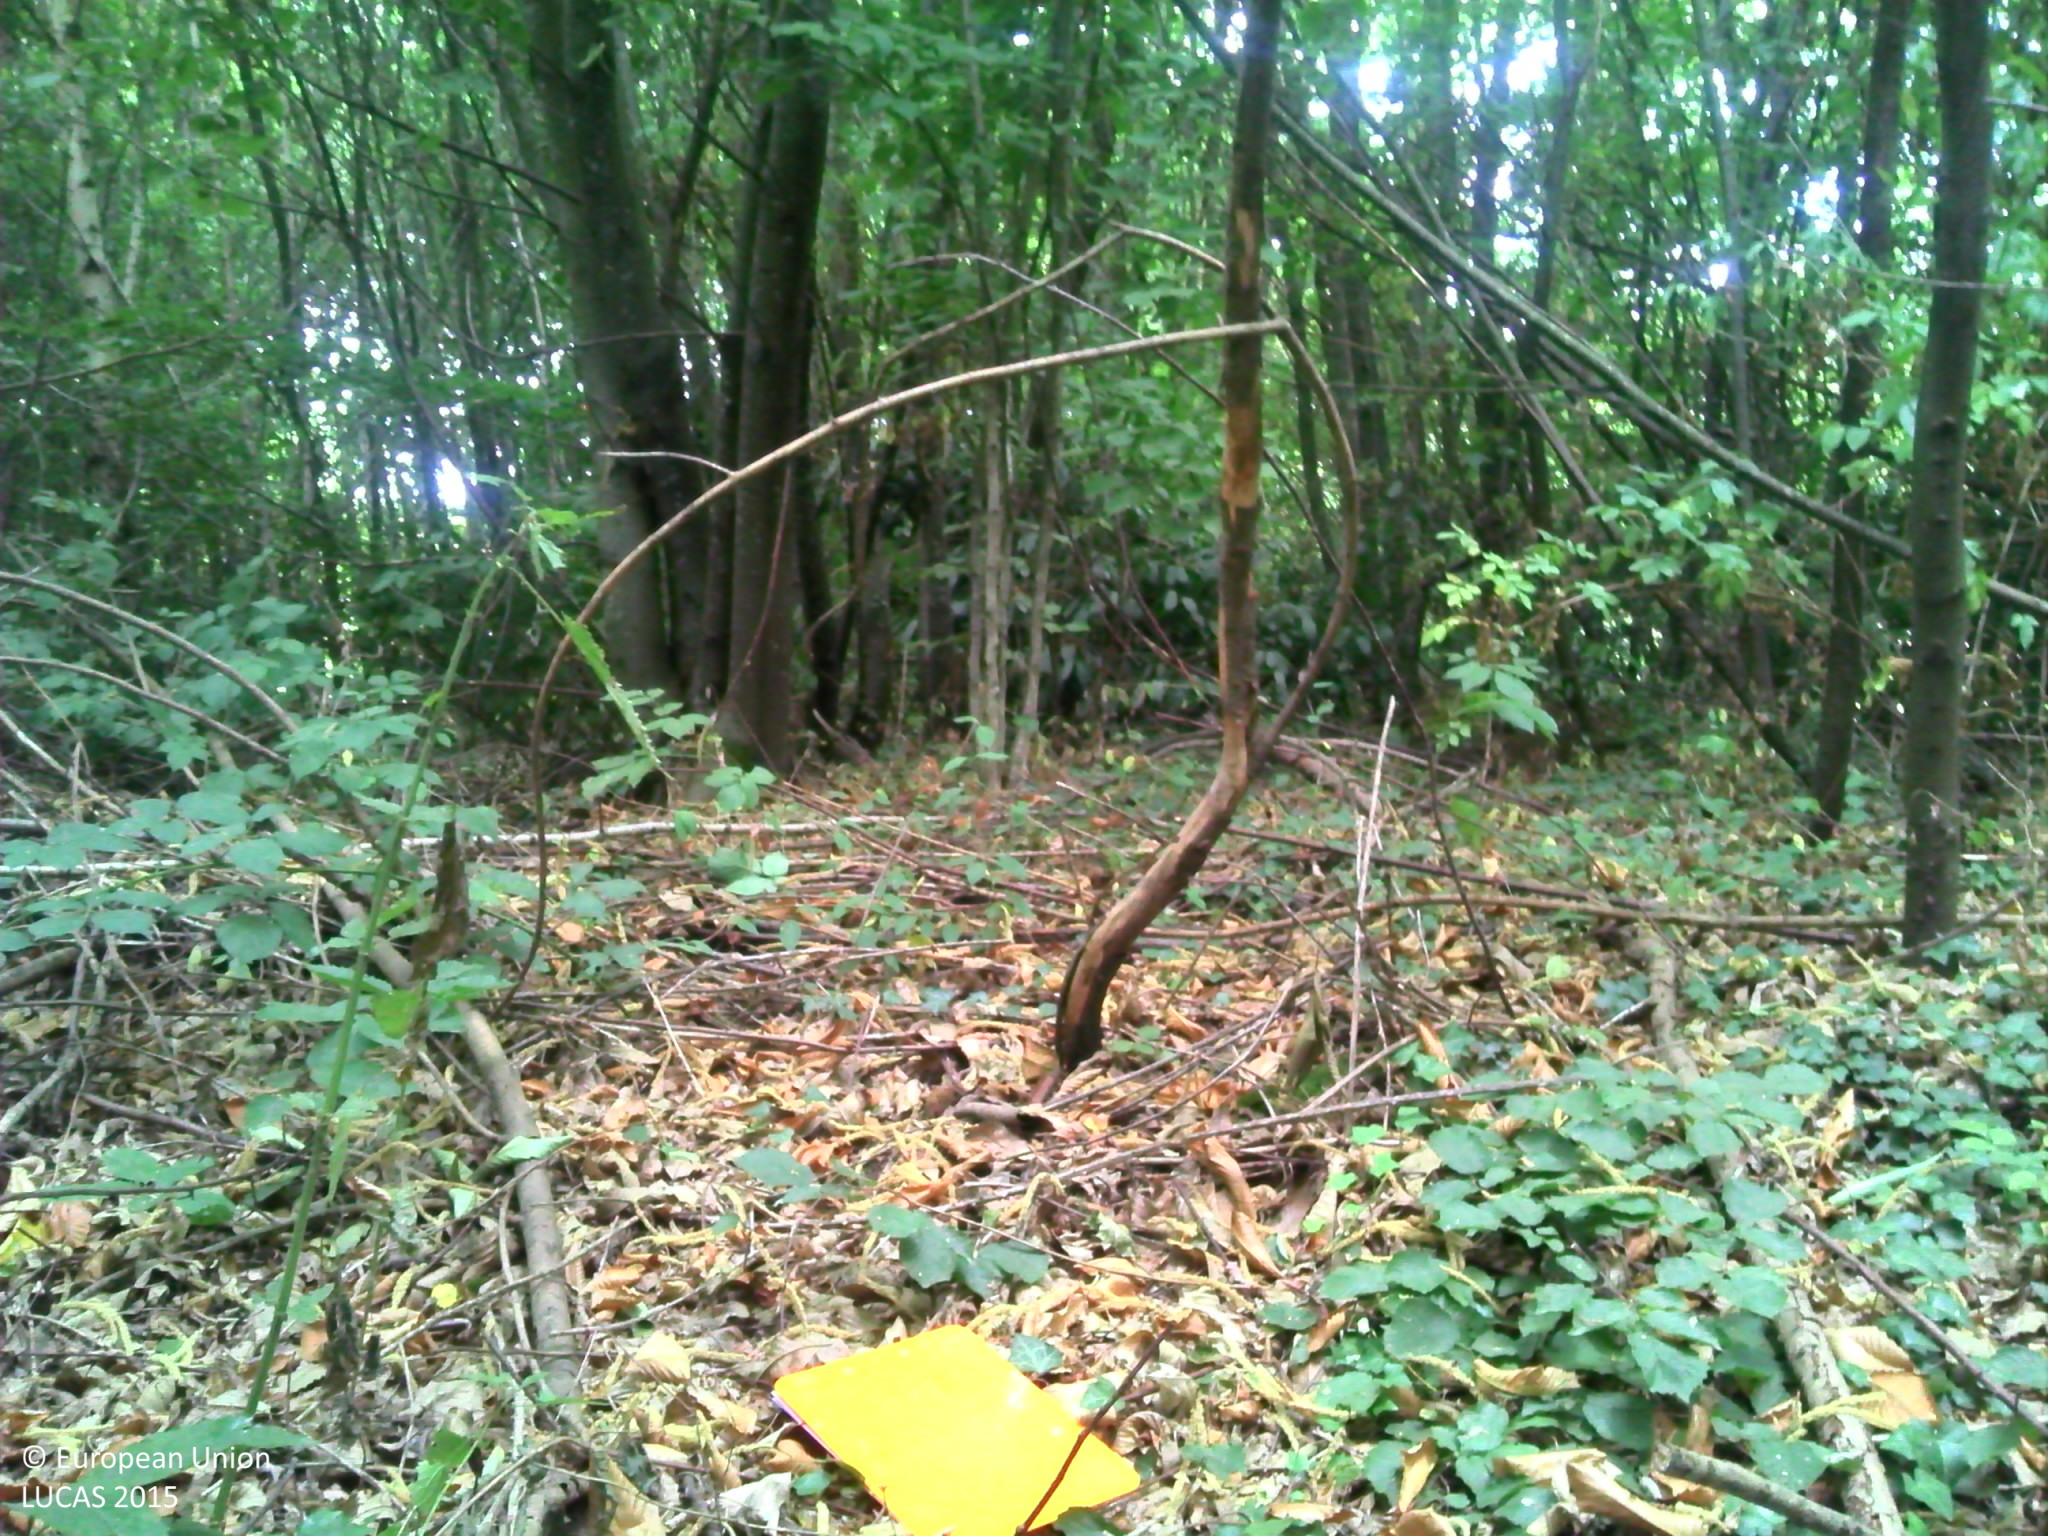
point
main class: Woodland
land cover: Broadleaved woodland
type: thermophilous deciduous forest
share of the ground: > 75 %
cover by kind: broadleaved forest trees 90 %, herbaceous plants 10 %
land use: Semi-natural and natural areas not in use
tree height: > 5 m
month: July
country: FR
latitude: 45.3704
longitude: 1.4005
